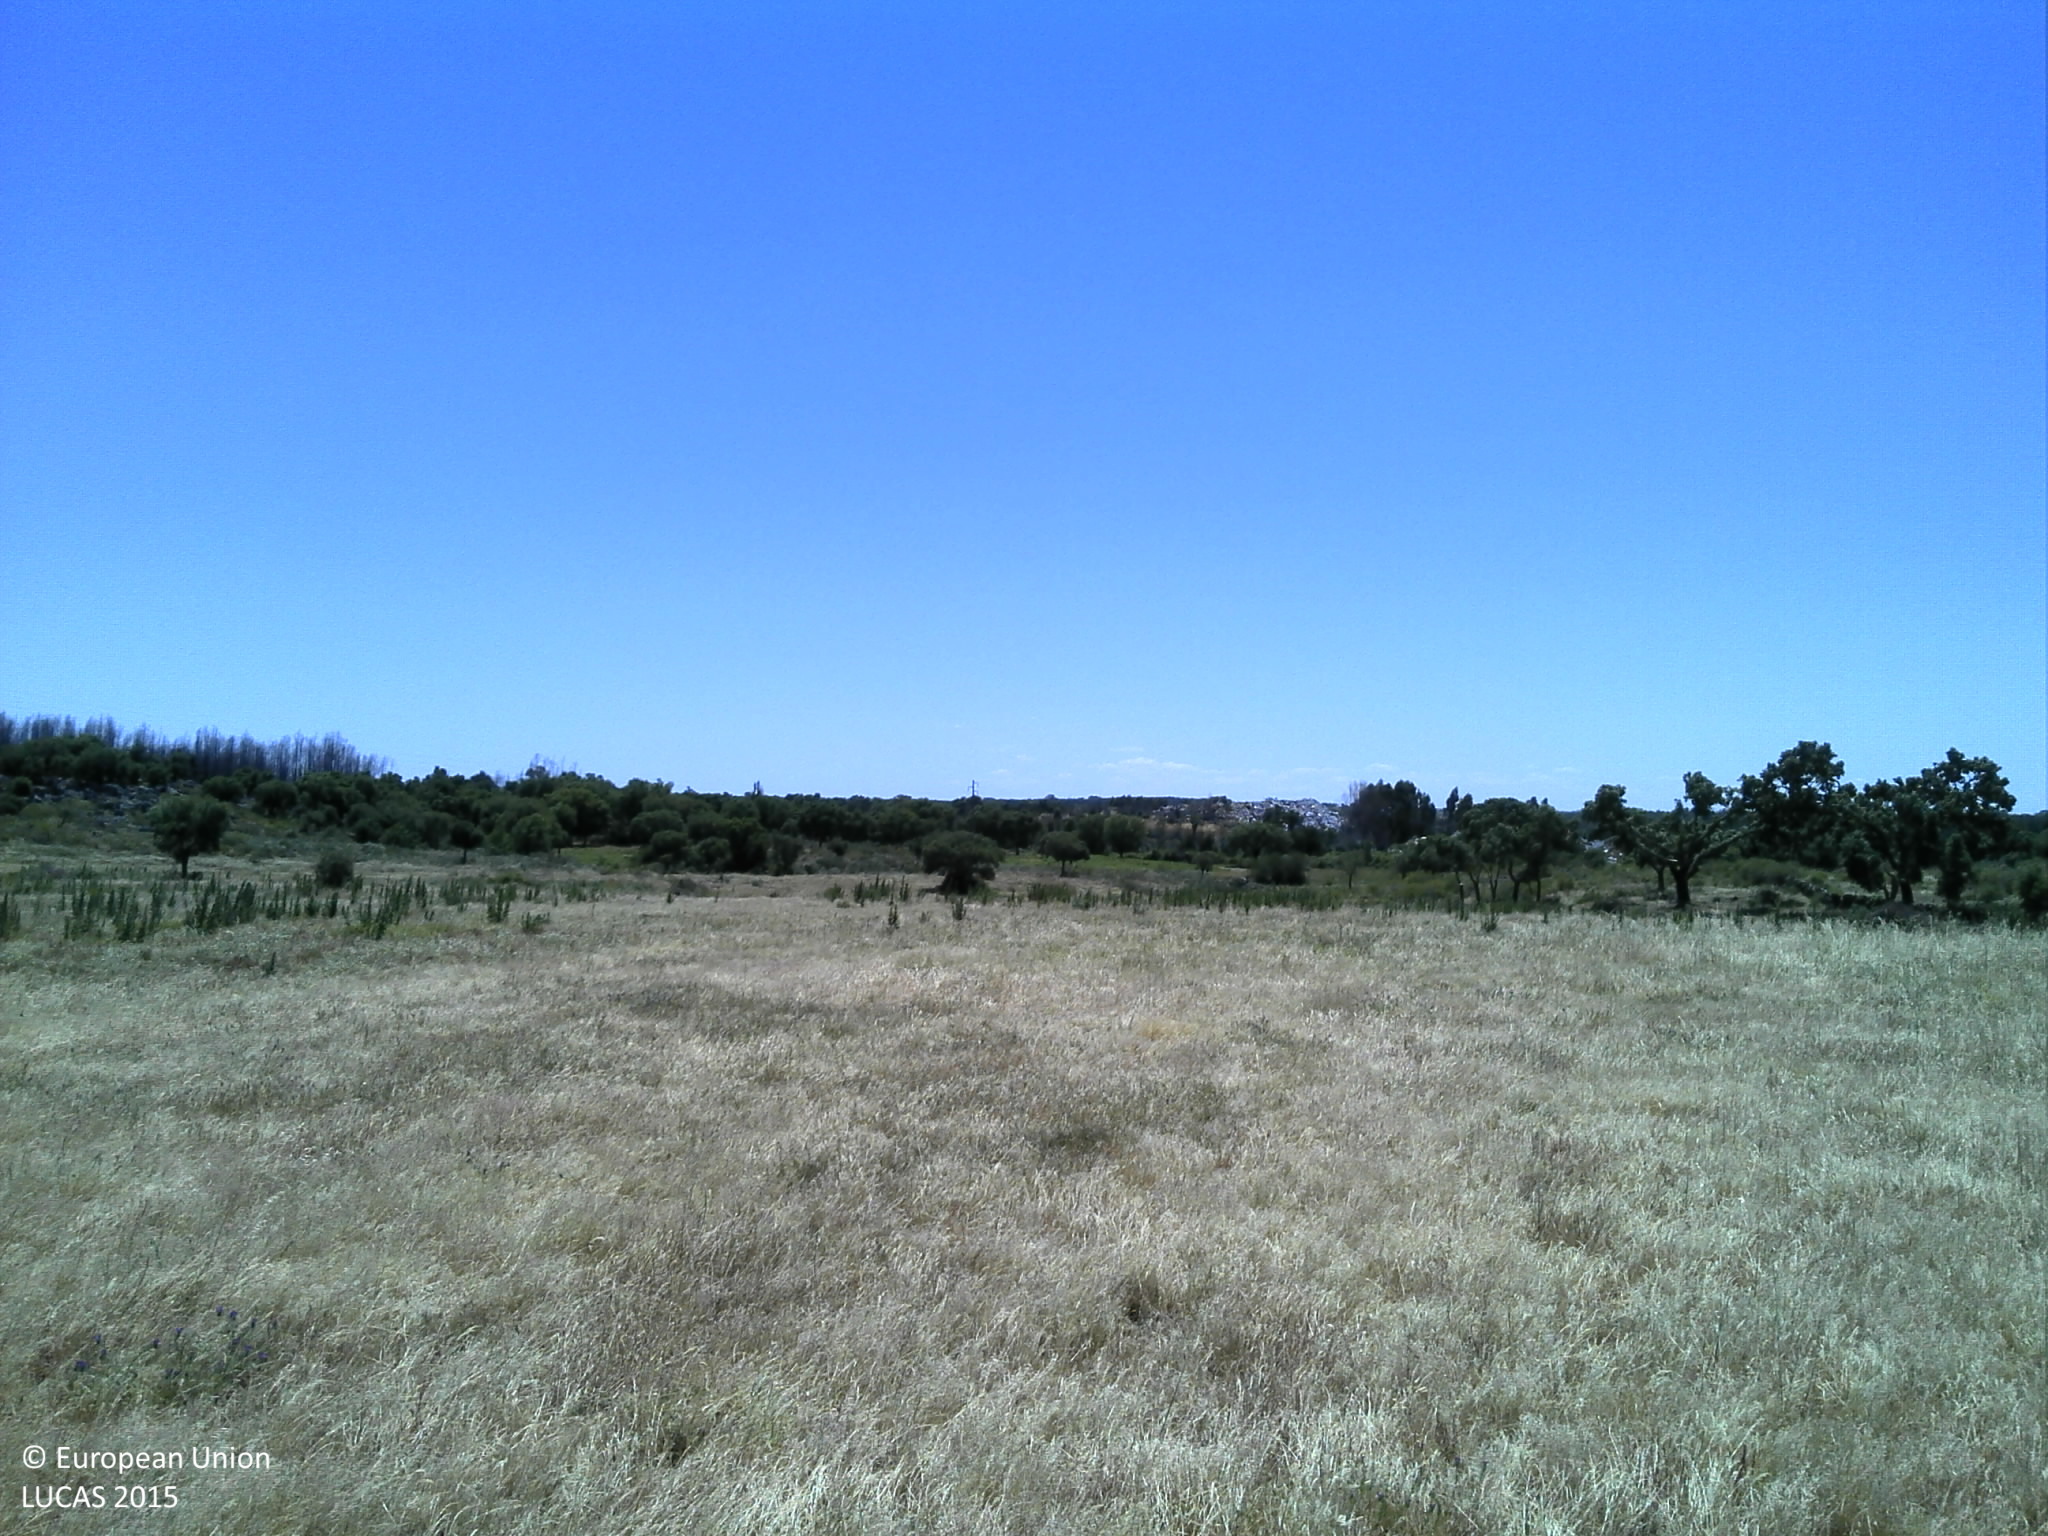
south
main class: Grassland
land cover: Grassland without tree/shrub cover
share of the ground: 50 - 75 %
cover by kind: herbaceous plants 75 %, unconsolidated bare surface 25 %
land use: Agriculture (excluding fallow land and kitchen gardens)
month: May
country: PT
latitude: 39.4462
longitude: -7.6539
